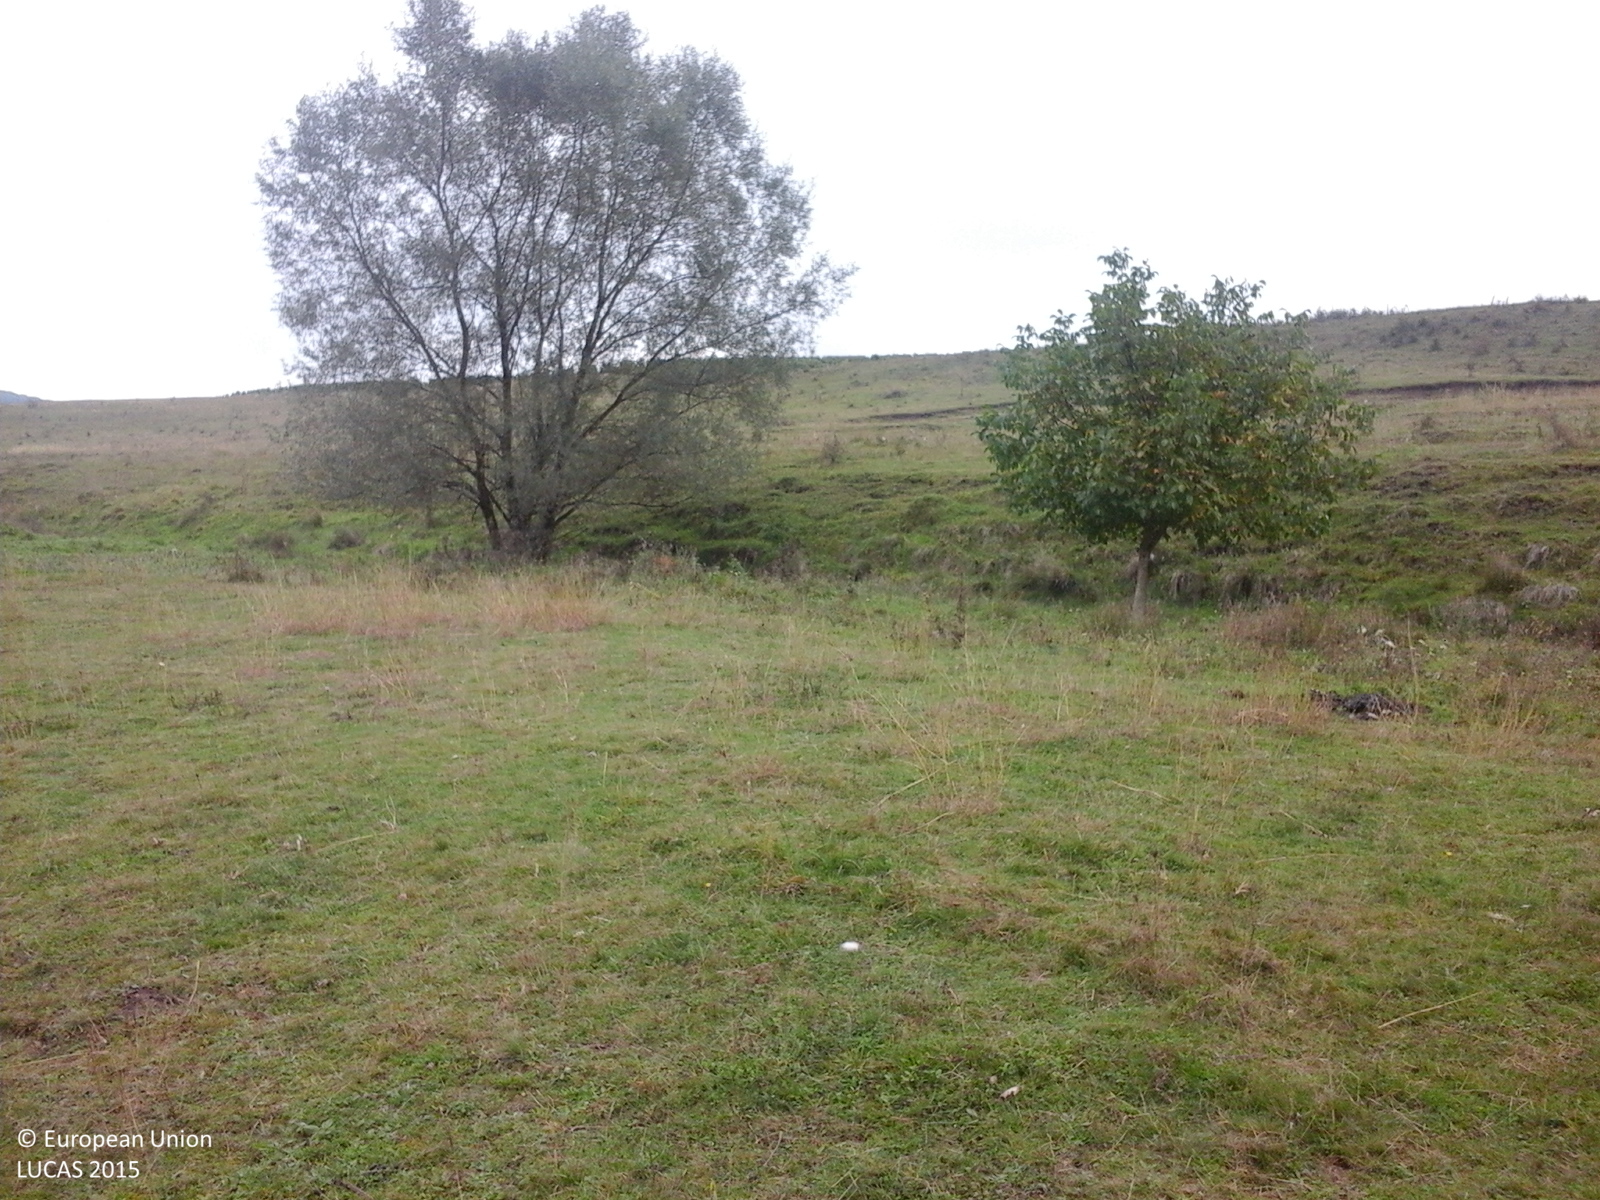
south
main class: Grassland
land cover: Grassland without tree/shrub cover
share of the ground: > 75 %
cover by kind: herbaceous plants 100 %
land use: Agriculture (excluding fallow land and kitchen gardens)
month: October
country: RO
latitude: 46.1958
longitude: 24.1107
